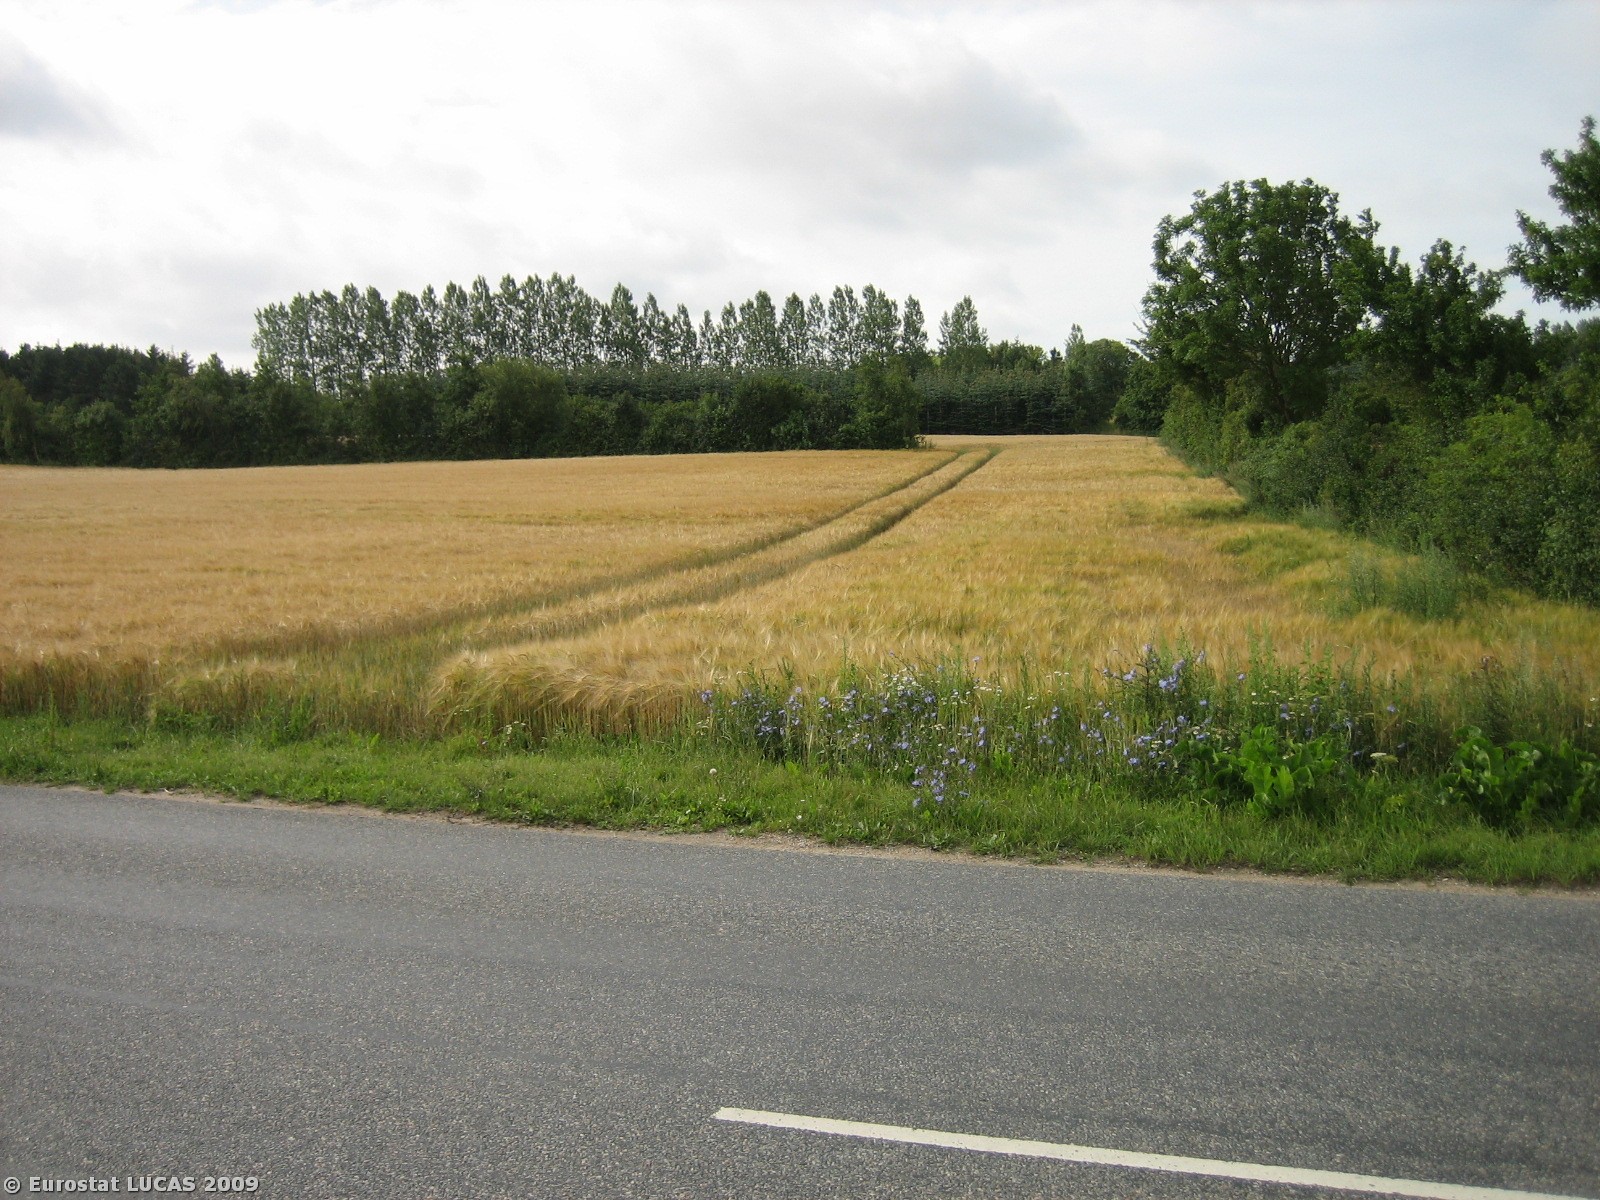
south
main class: Cropland
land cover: Common wheat
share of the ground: > 75 %
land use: Agriculture (excluding fallow land and kitchen gardens)
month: July
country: DK
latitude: 55.2171
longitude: 10.0471
